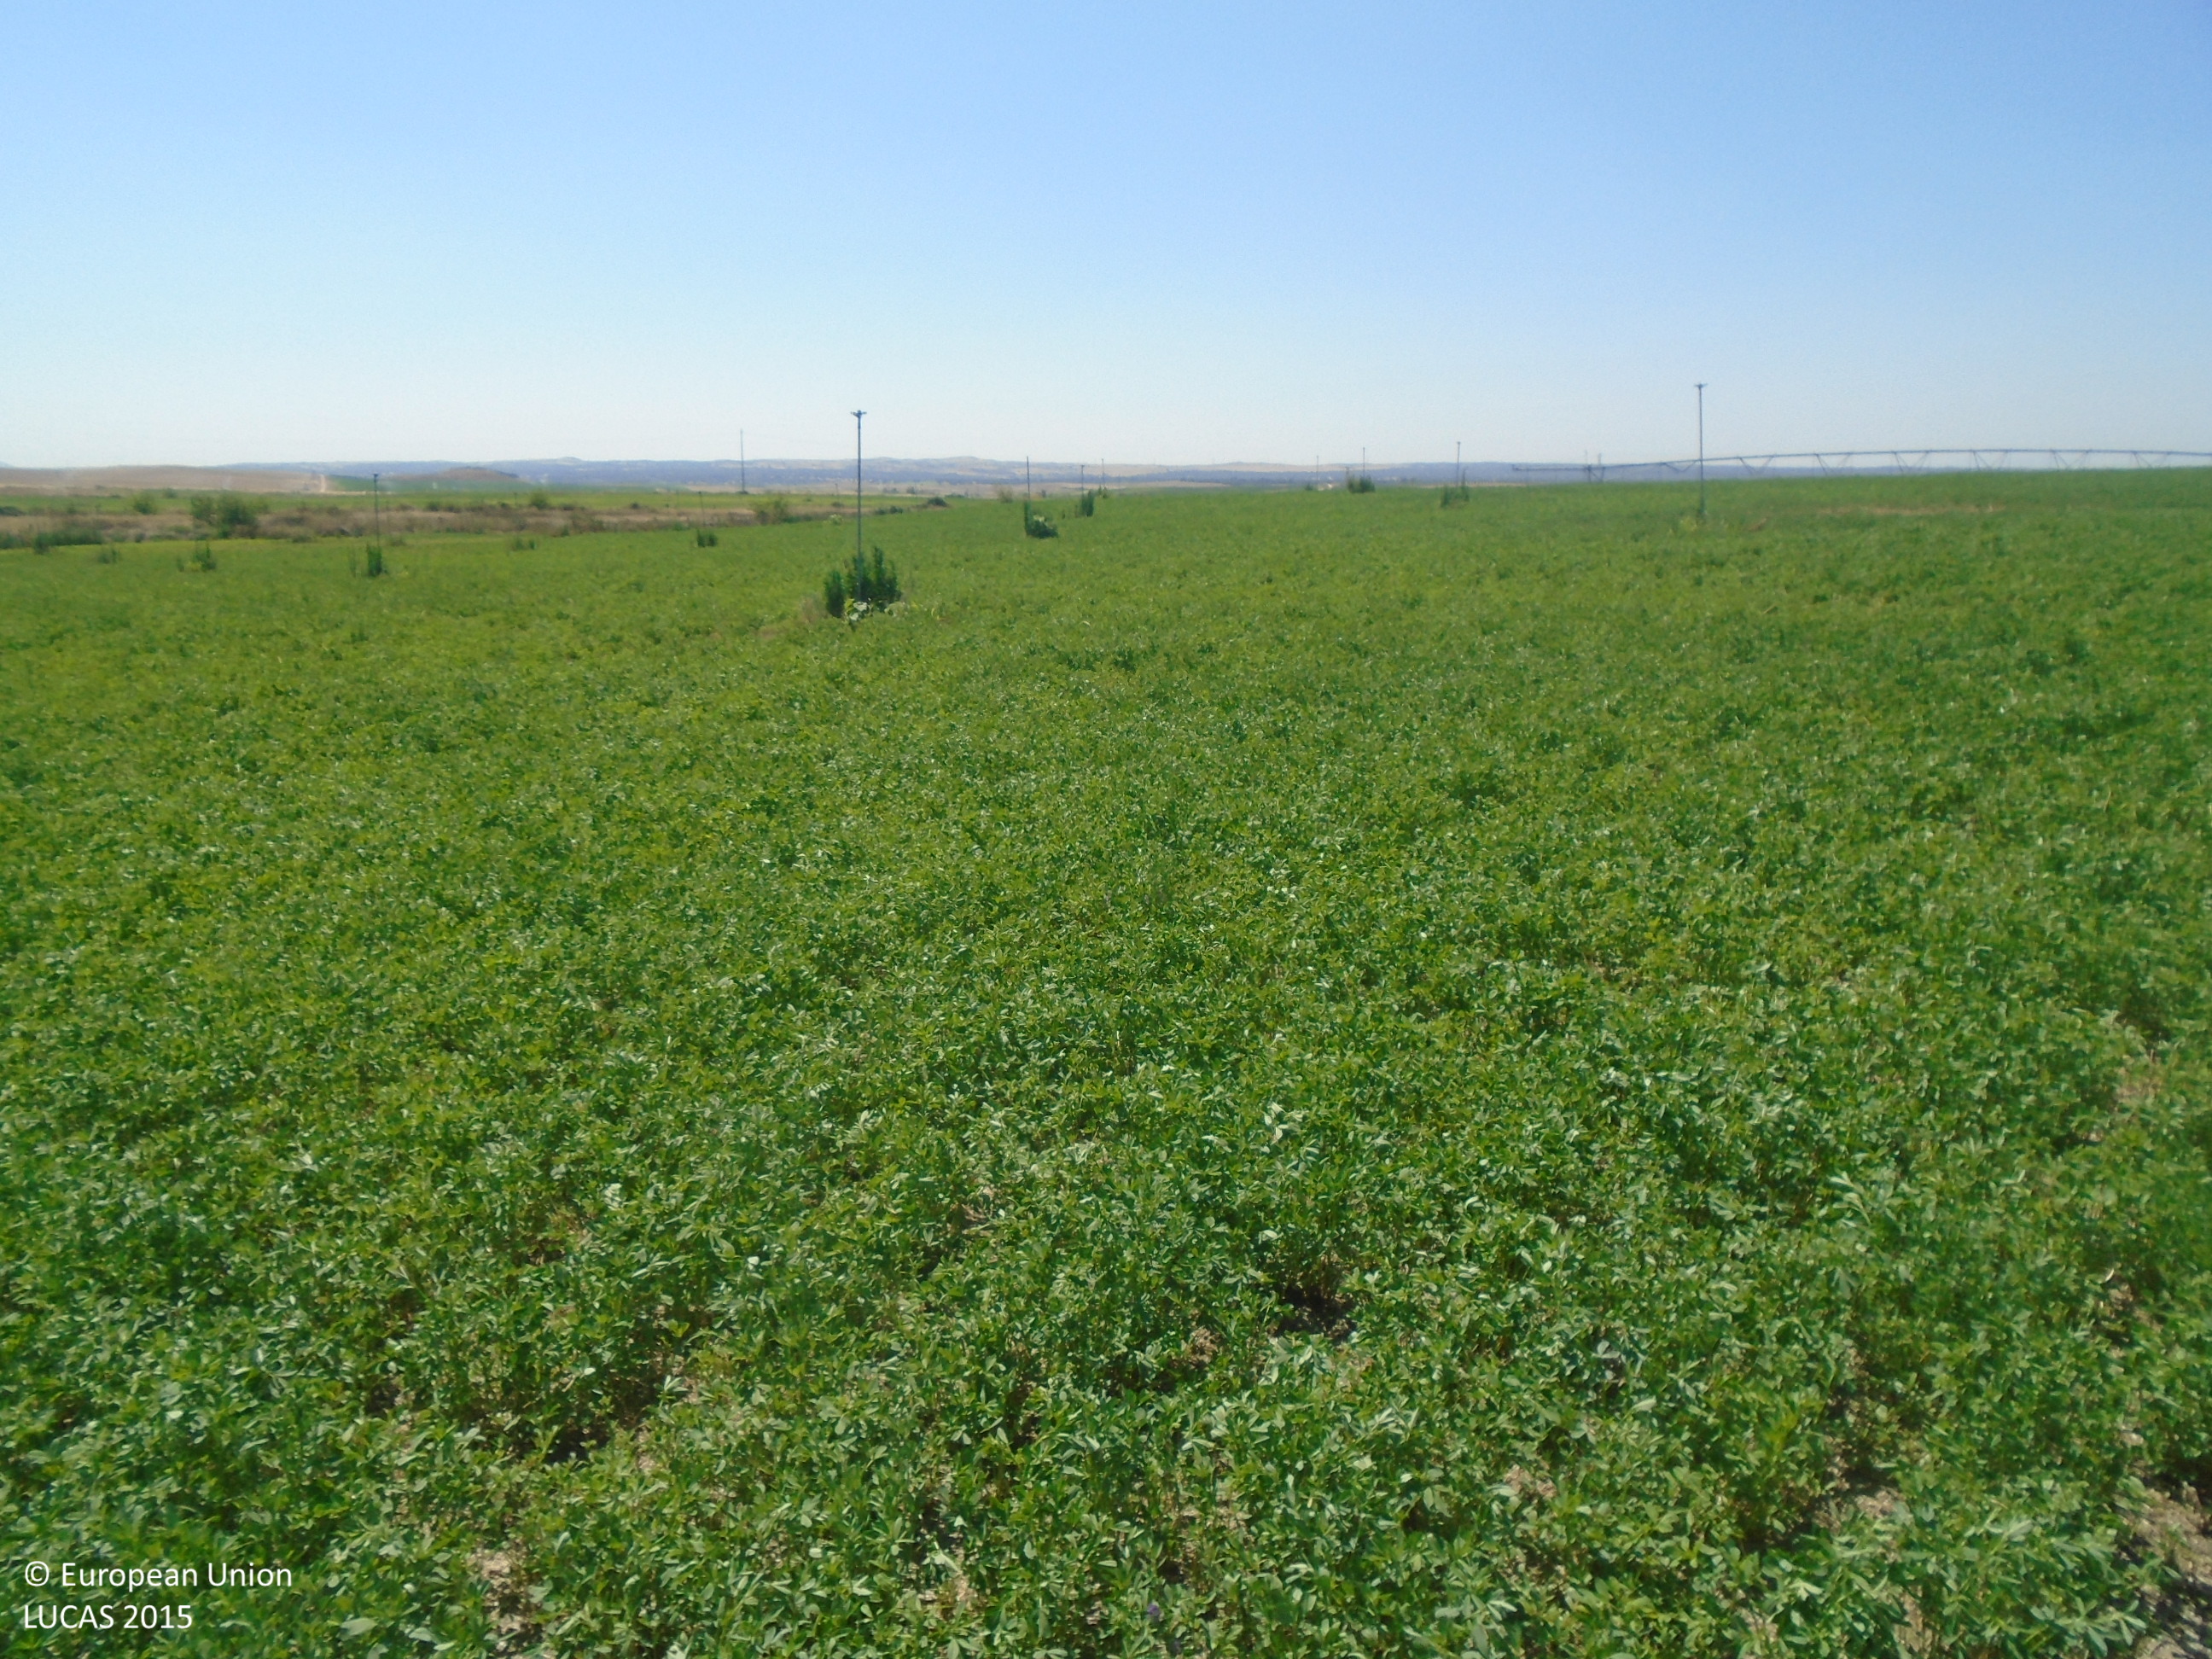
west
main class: Cropland
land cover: Lucerne
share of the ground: > 75 %
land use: Agriculture (excluding fallow land and kitchen gardens)
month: July
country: ES
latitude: 39.8243
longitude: -5.1102
